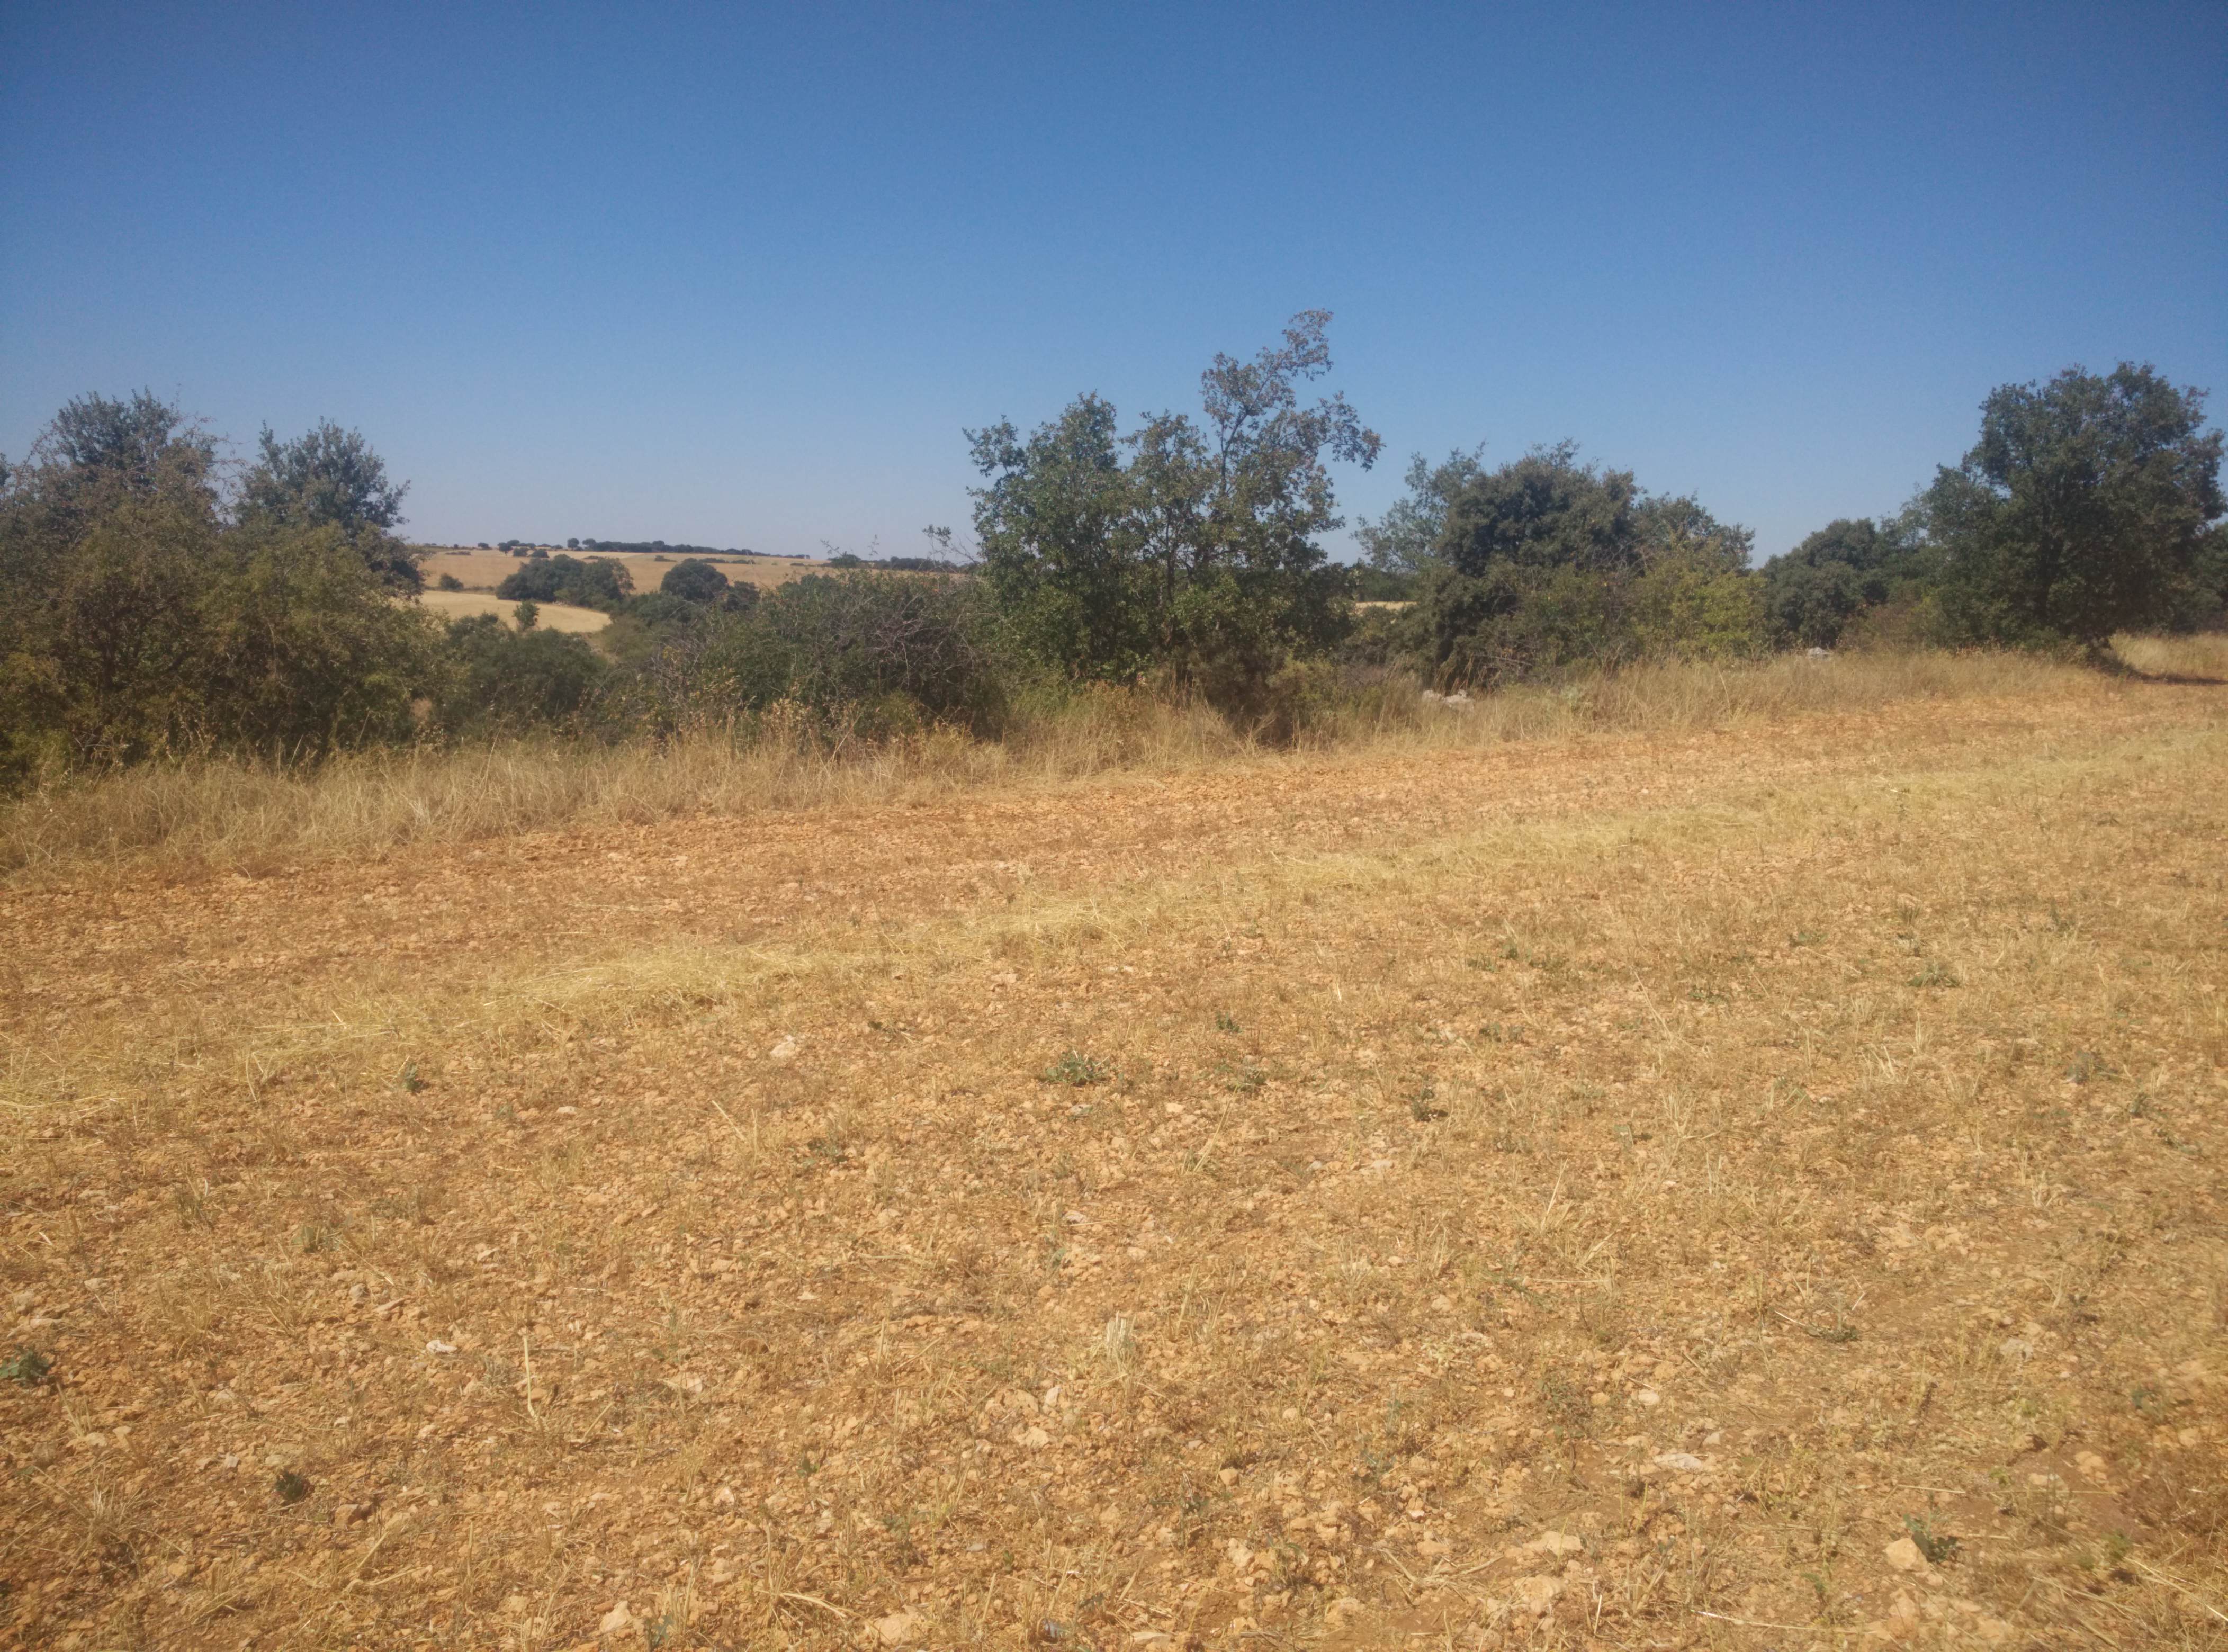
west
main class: Cropland
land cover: Common wheat
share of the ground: < 10 %
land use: Agriculture (excluding fallow land and kitchen gardens)
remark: Harvested field
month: July
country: ES
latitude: 40.6279
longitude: -2.8329
